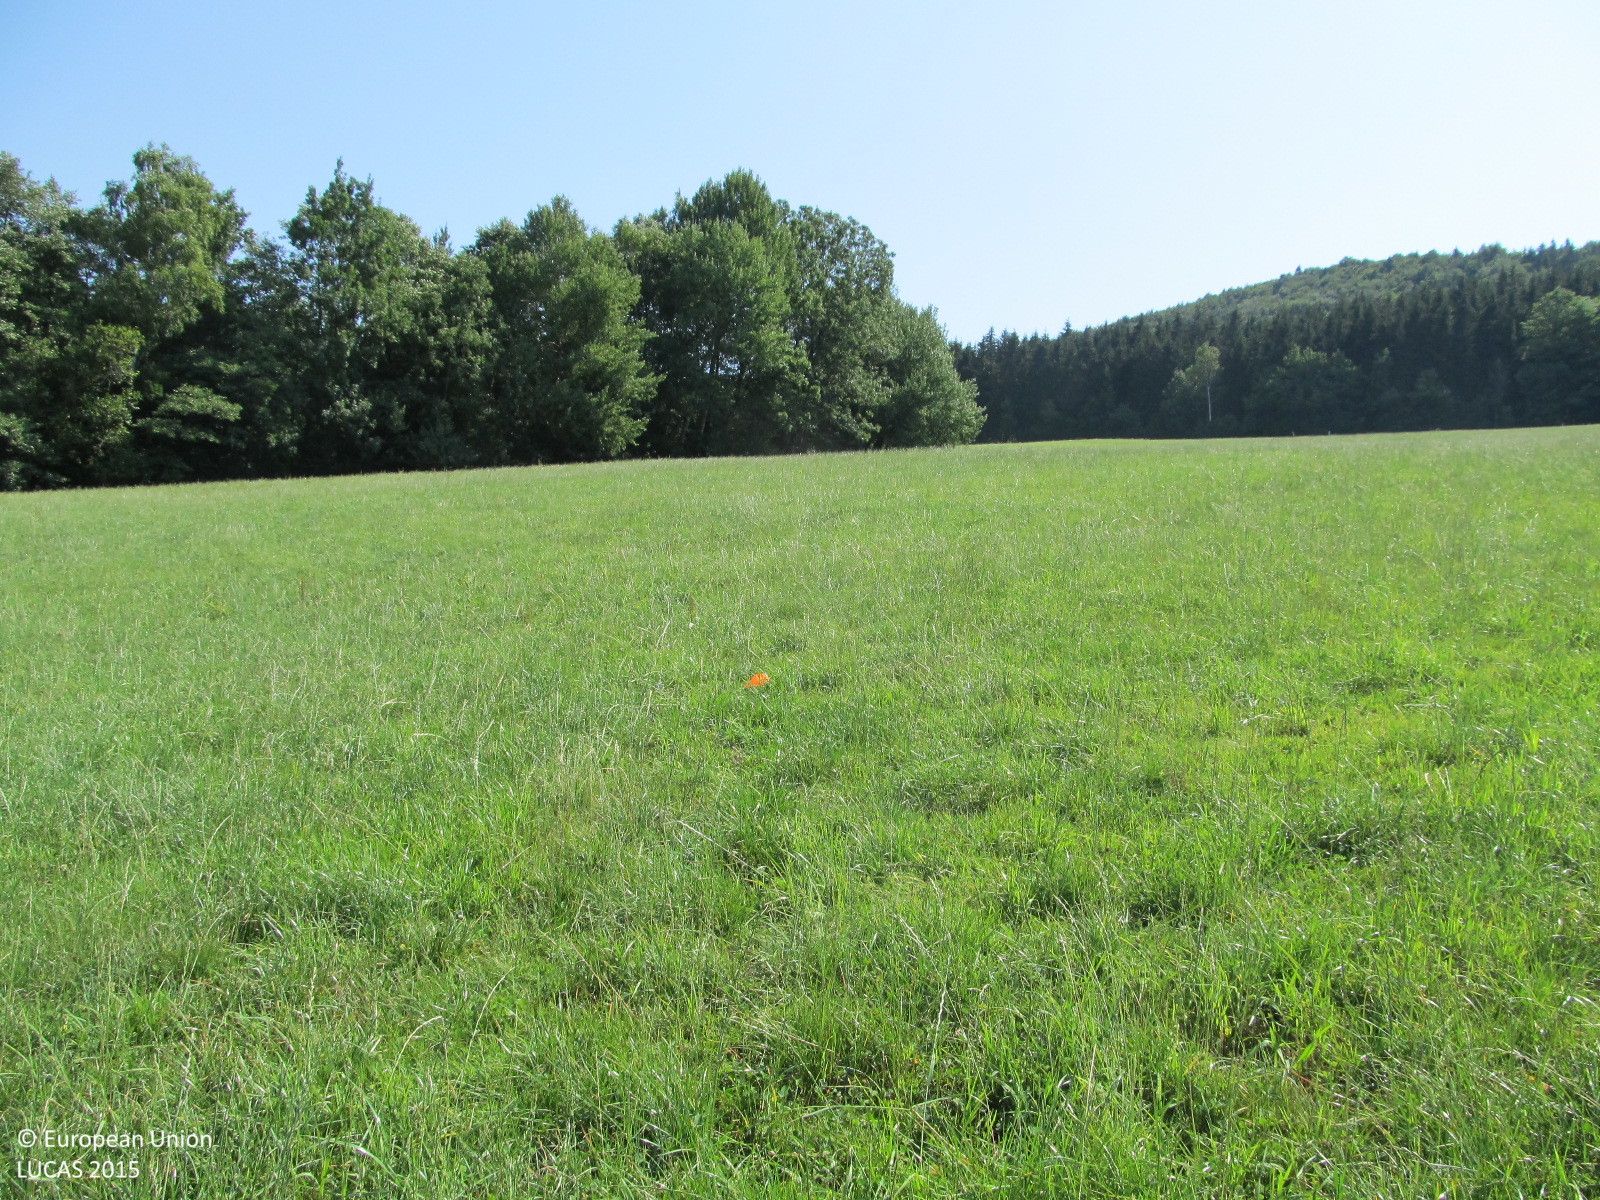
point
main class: Grassland
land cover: Grassland without tree/shrub cover
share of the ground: > 75 %
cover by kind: herbaceous plants 100 %
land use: Agriculture (excluding fallow land and kitchen gardens)
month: August
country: AT
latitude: 48.0729
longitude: 15.7606
